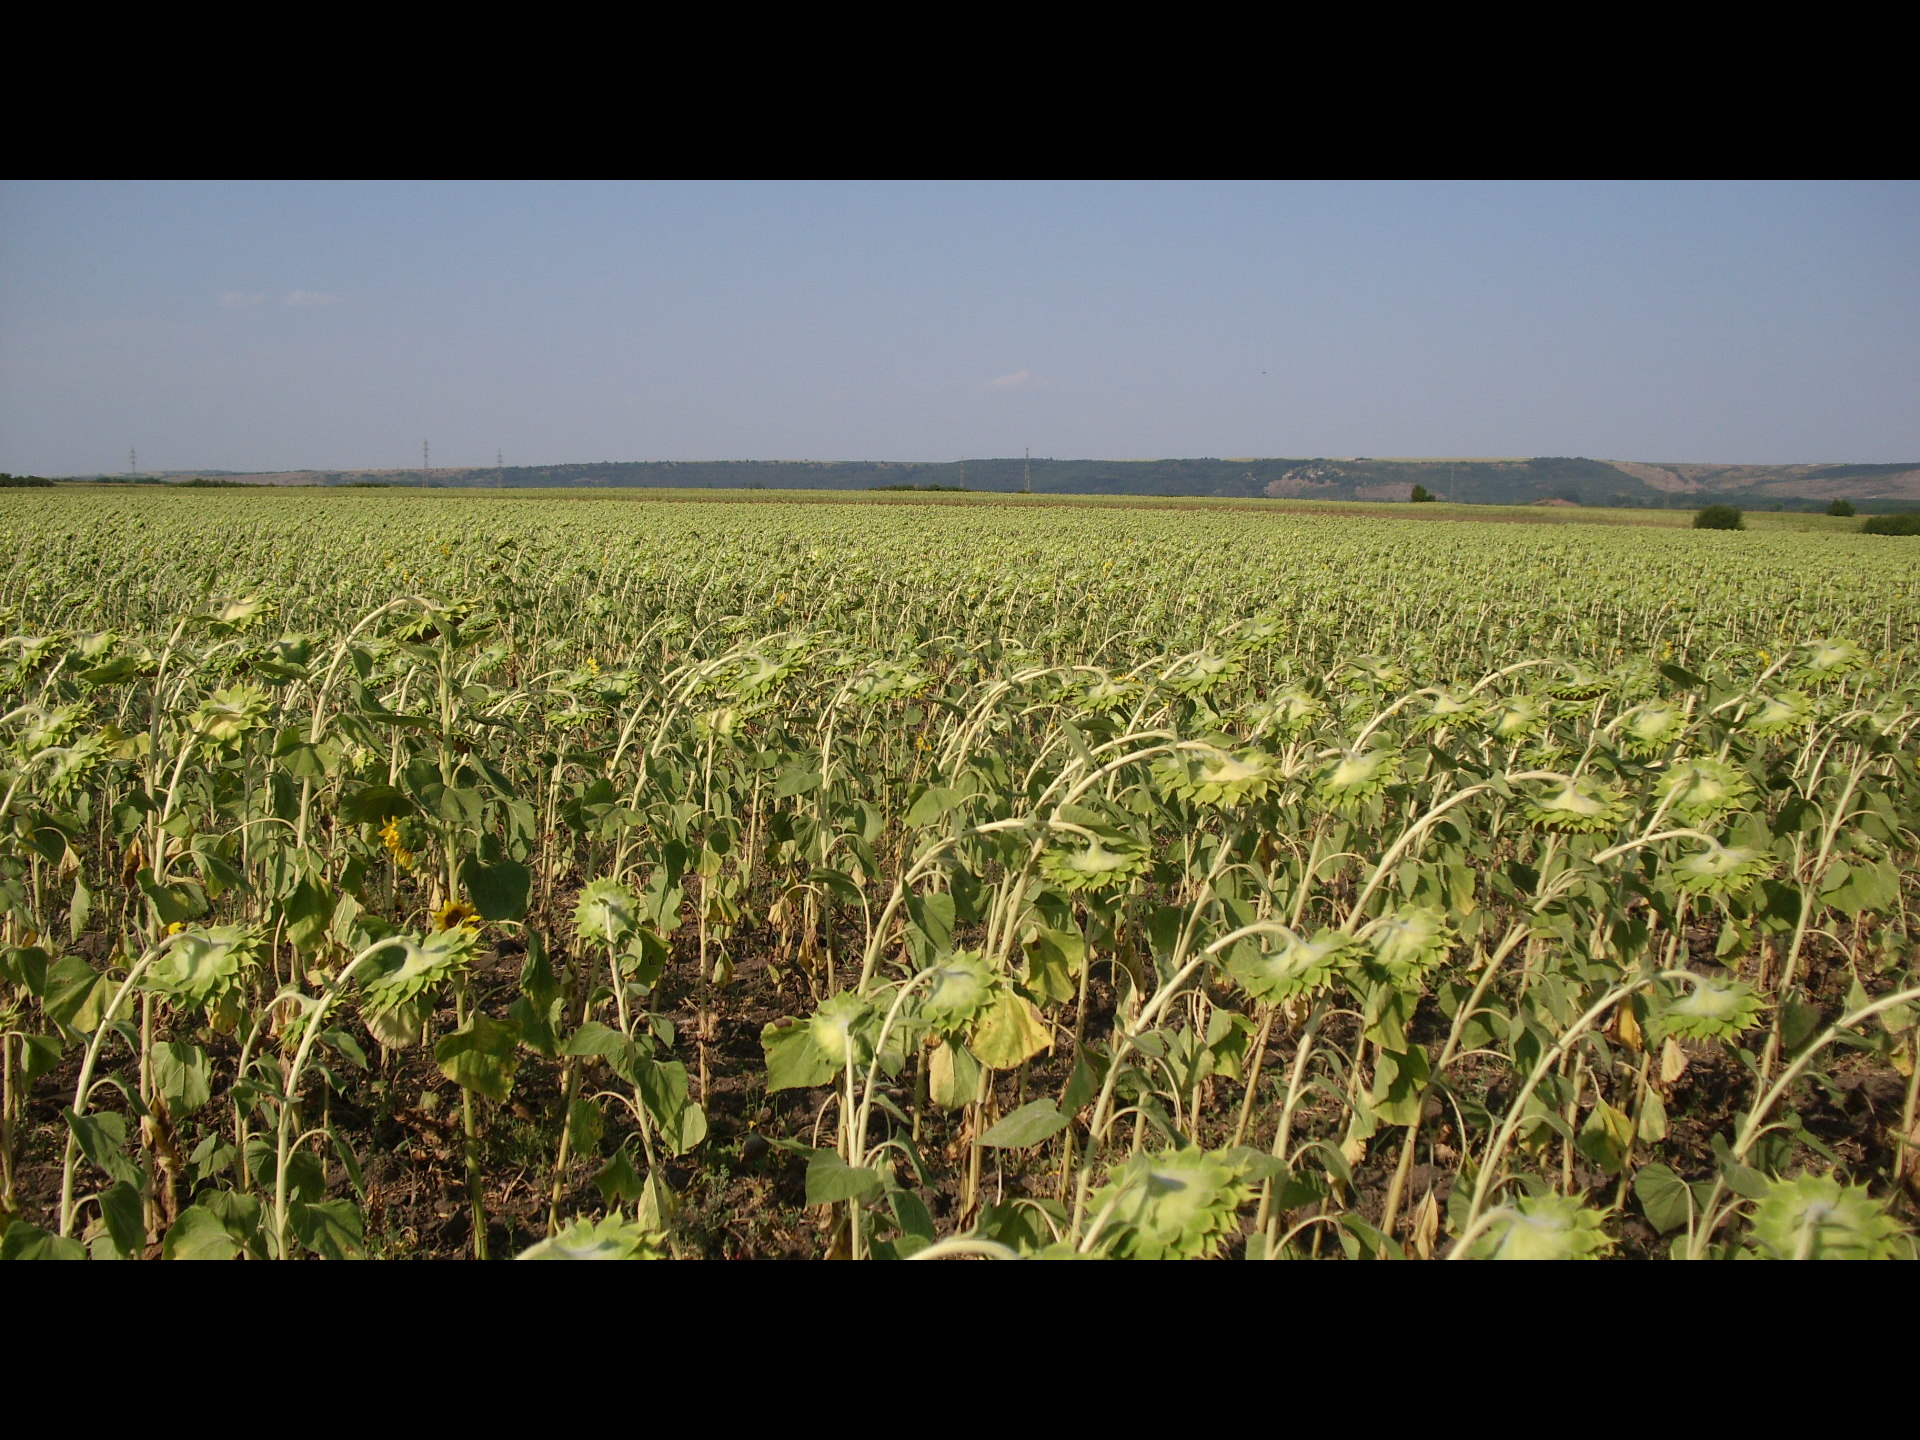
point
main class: Cropland
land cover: Sunflower
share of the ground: > 75 %
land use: Agriculture (excluding fallow land and kitchen gardens)
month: August
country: BG
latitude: 43.3633
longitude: 23.4308
